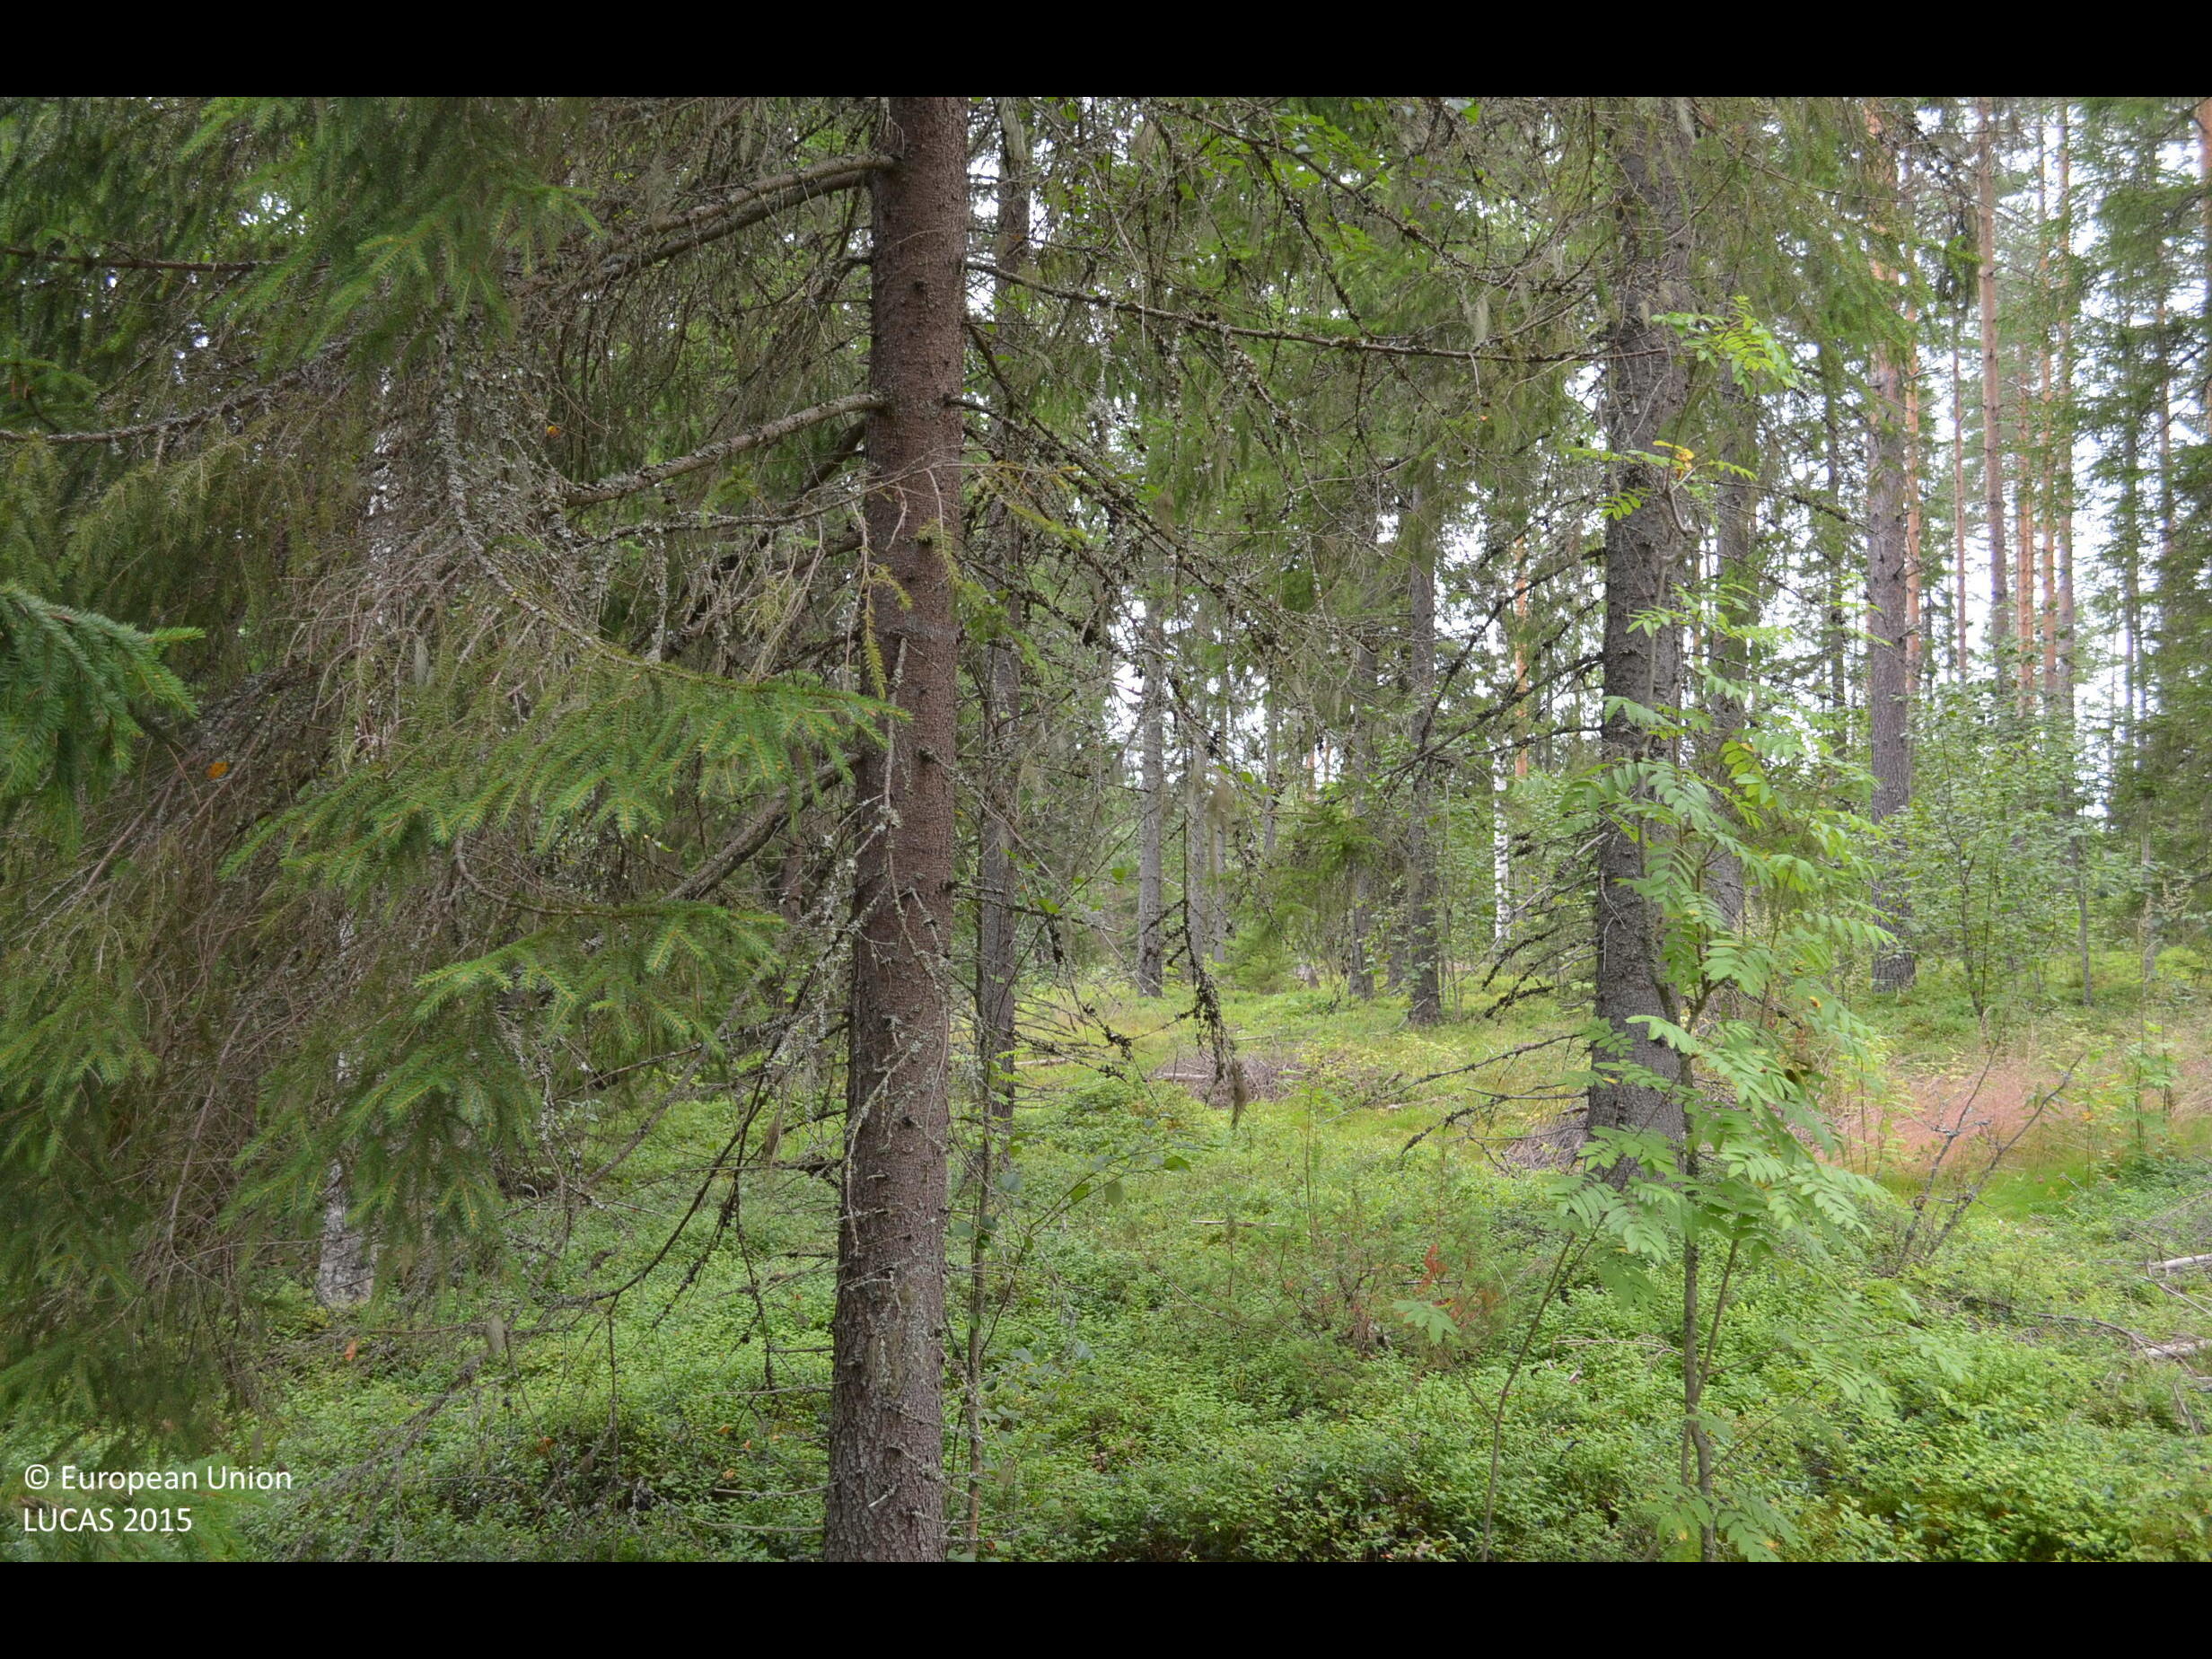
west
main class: Woodland
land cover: Other mixed woodland
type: boreal forest
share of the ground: > 75 %
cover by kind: coniferous forest trees 60 %, broadleaved forest trees 20 %, shrubs 15 %, lichens and mosses 5 %
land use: Forestry
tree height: > 5 m
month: August
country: FI
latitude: 62.2153
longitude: 24.3381
